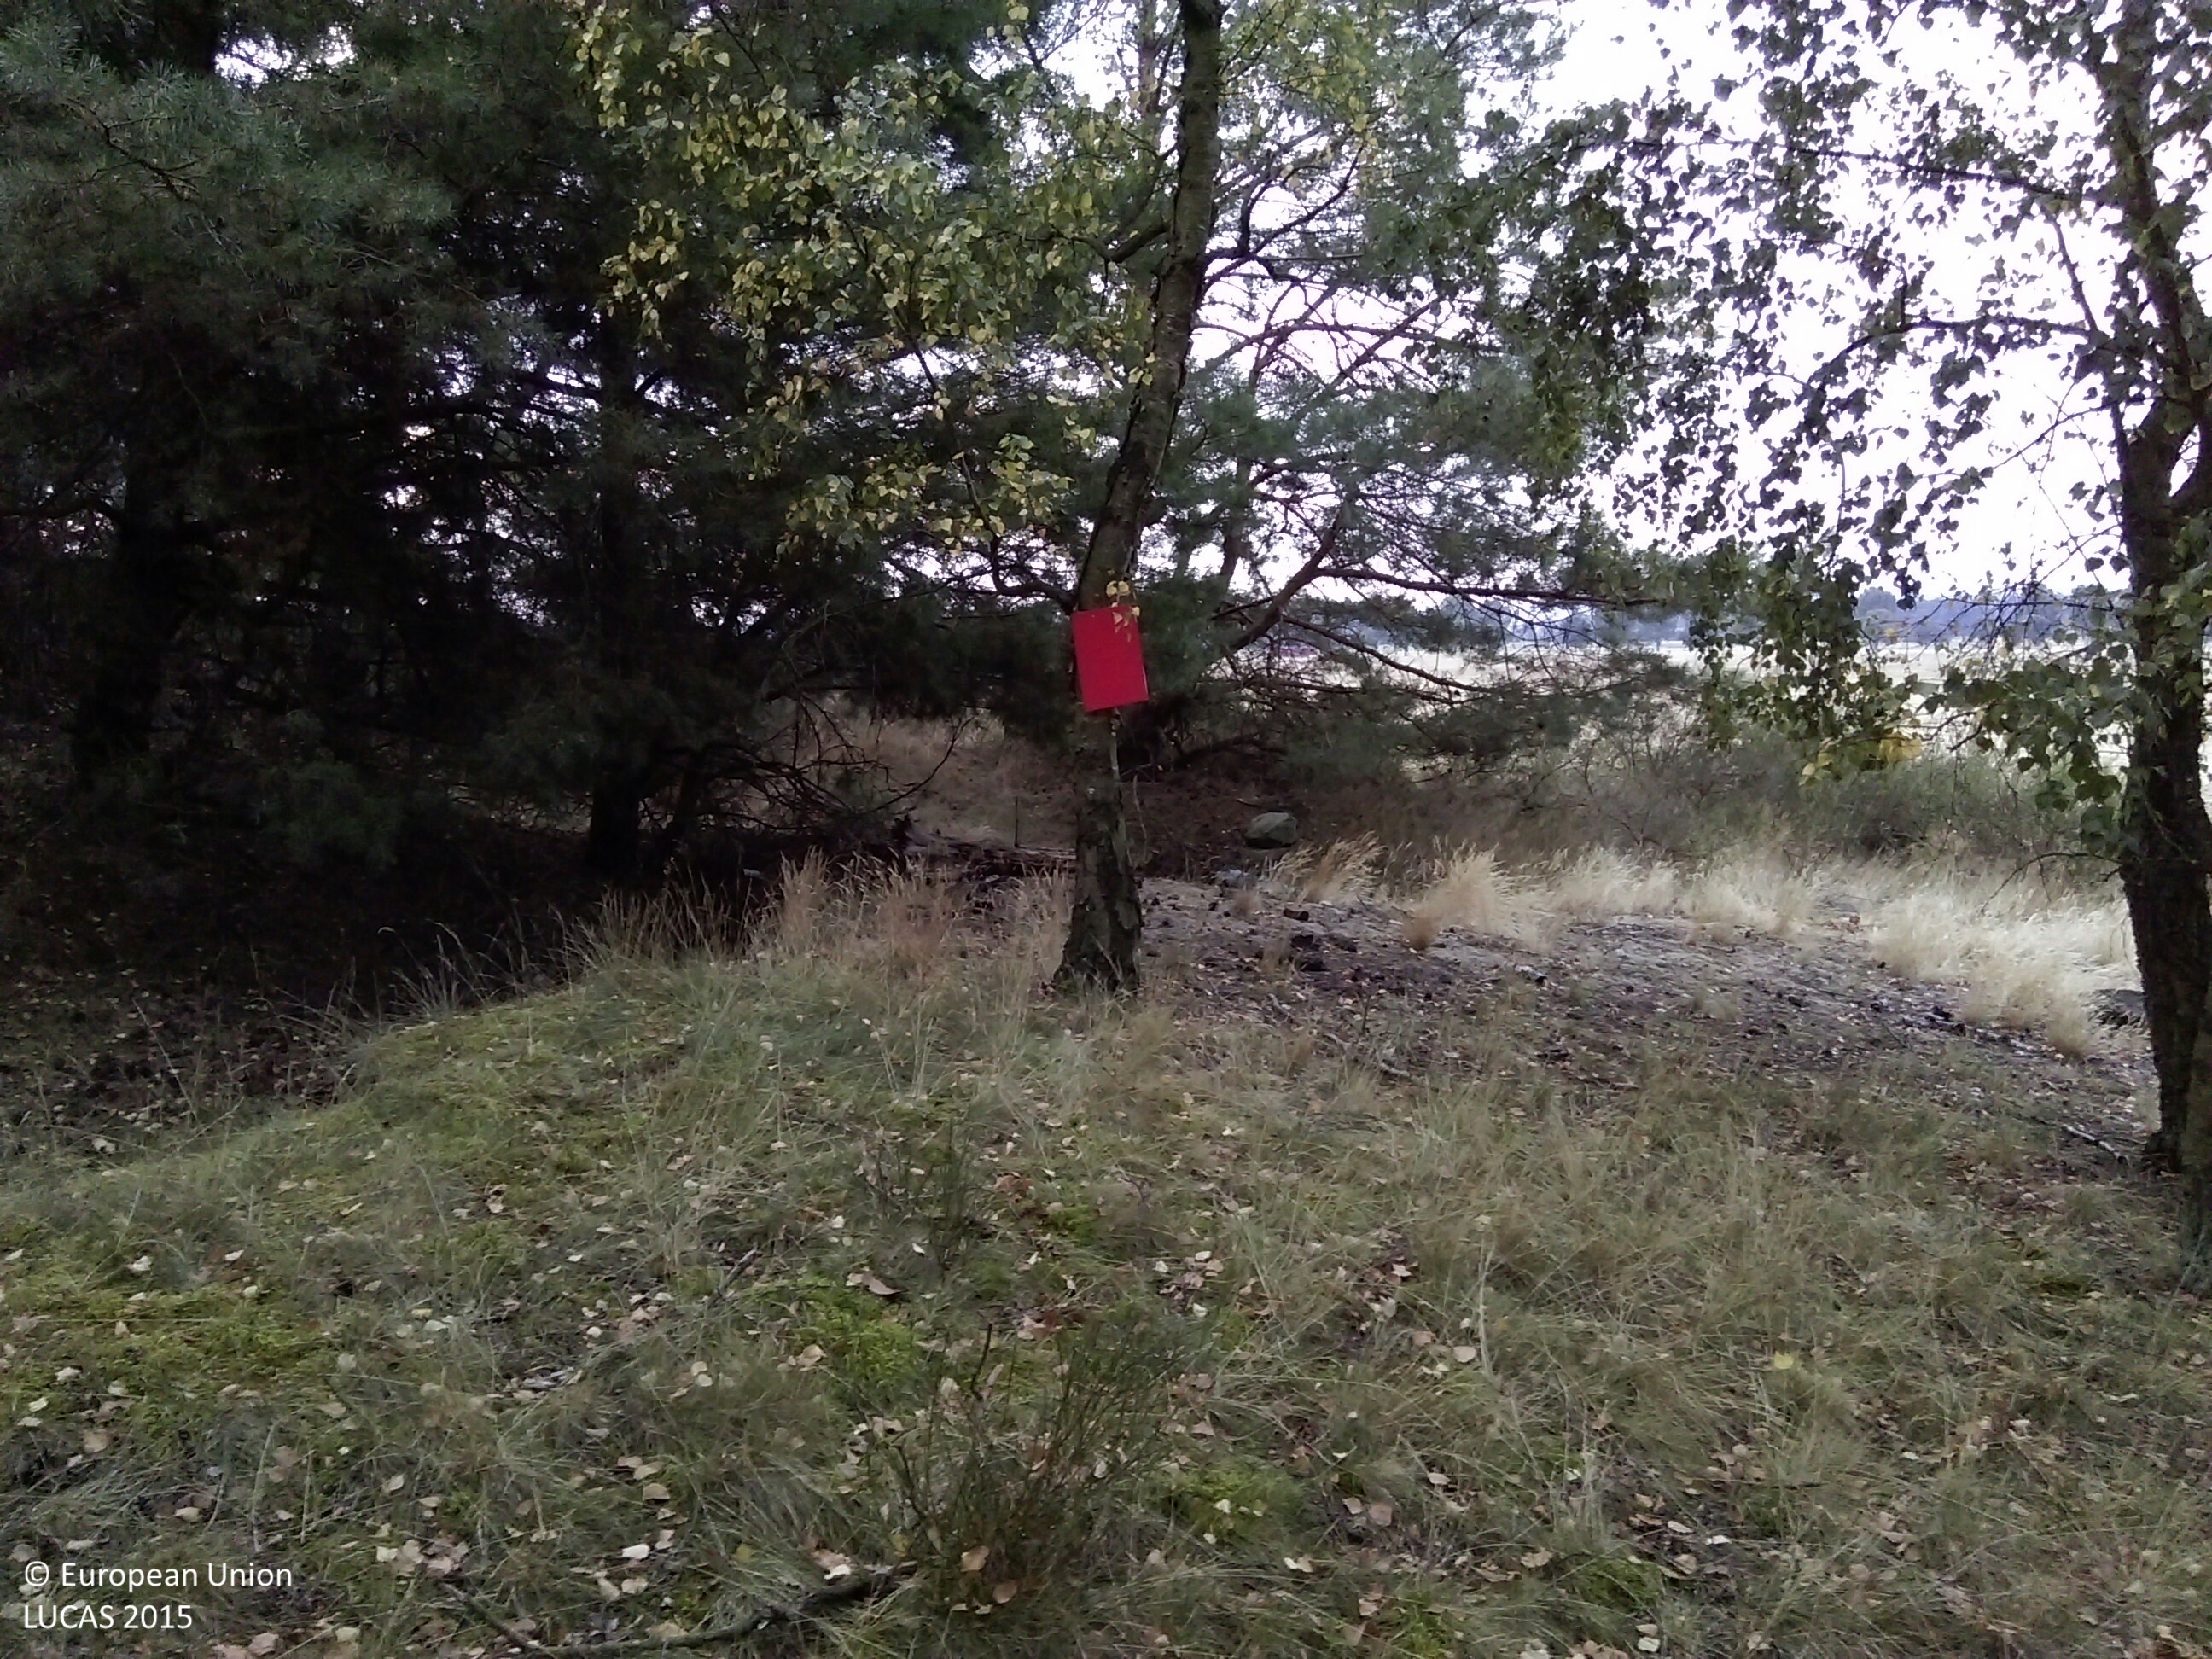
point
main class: Woodland
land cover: Pine dominated mixed woodland
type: hemiboreal forest and nemoral coniferous forest and mixed broadleaved-coniferous forest
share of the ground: 50 - 75 %
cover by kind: coniferous forest trees 40 %, broadleaved forest trees 30 %, herbaceous plants 15 %, unconsolidated bare surface 15 %
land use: Forestry
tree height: > 5 m
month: August
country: PL
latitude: 52.2805
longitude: 15.6183
